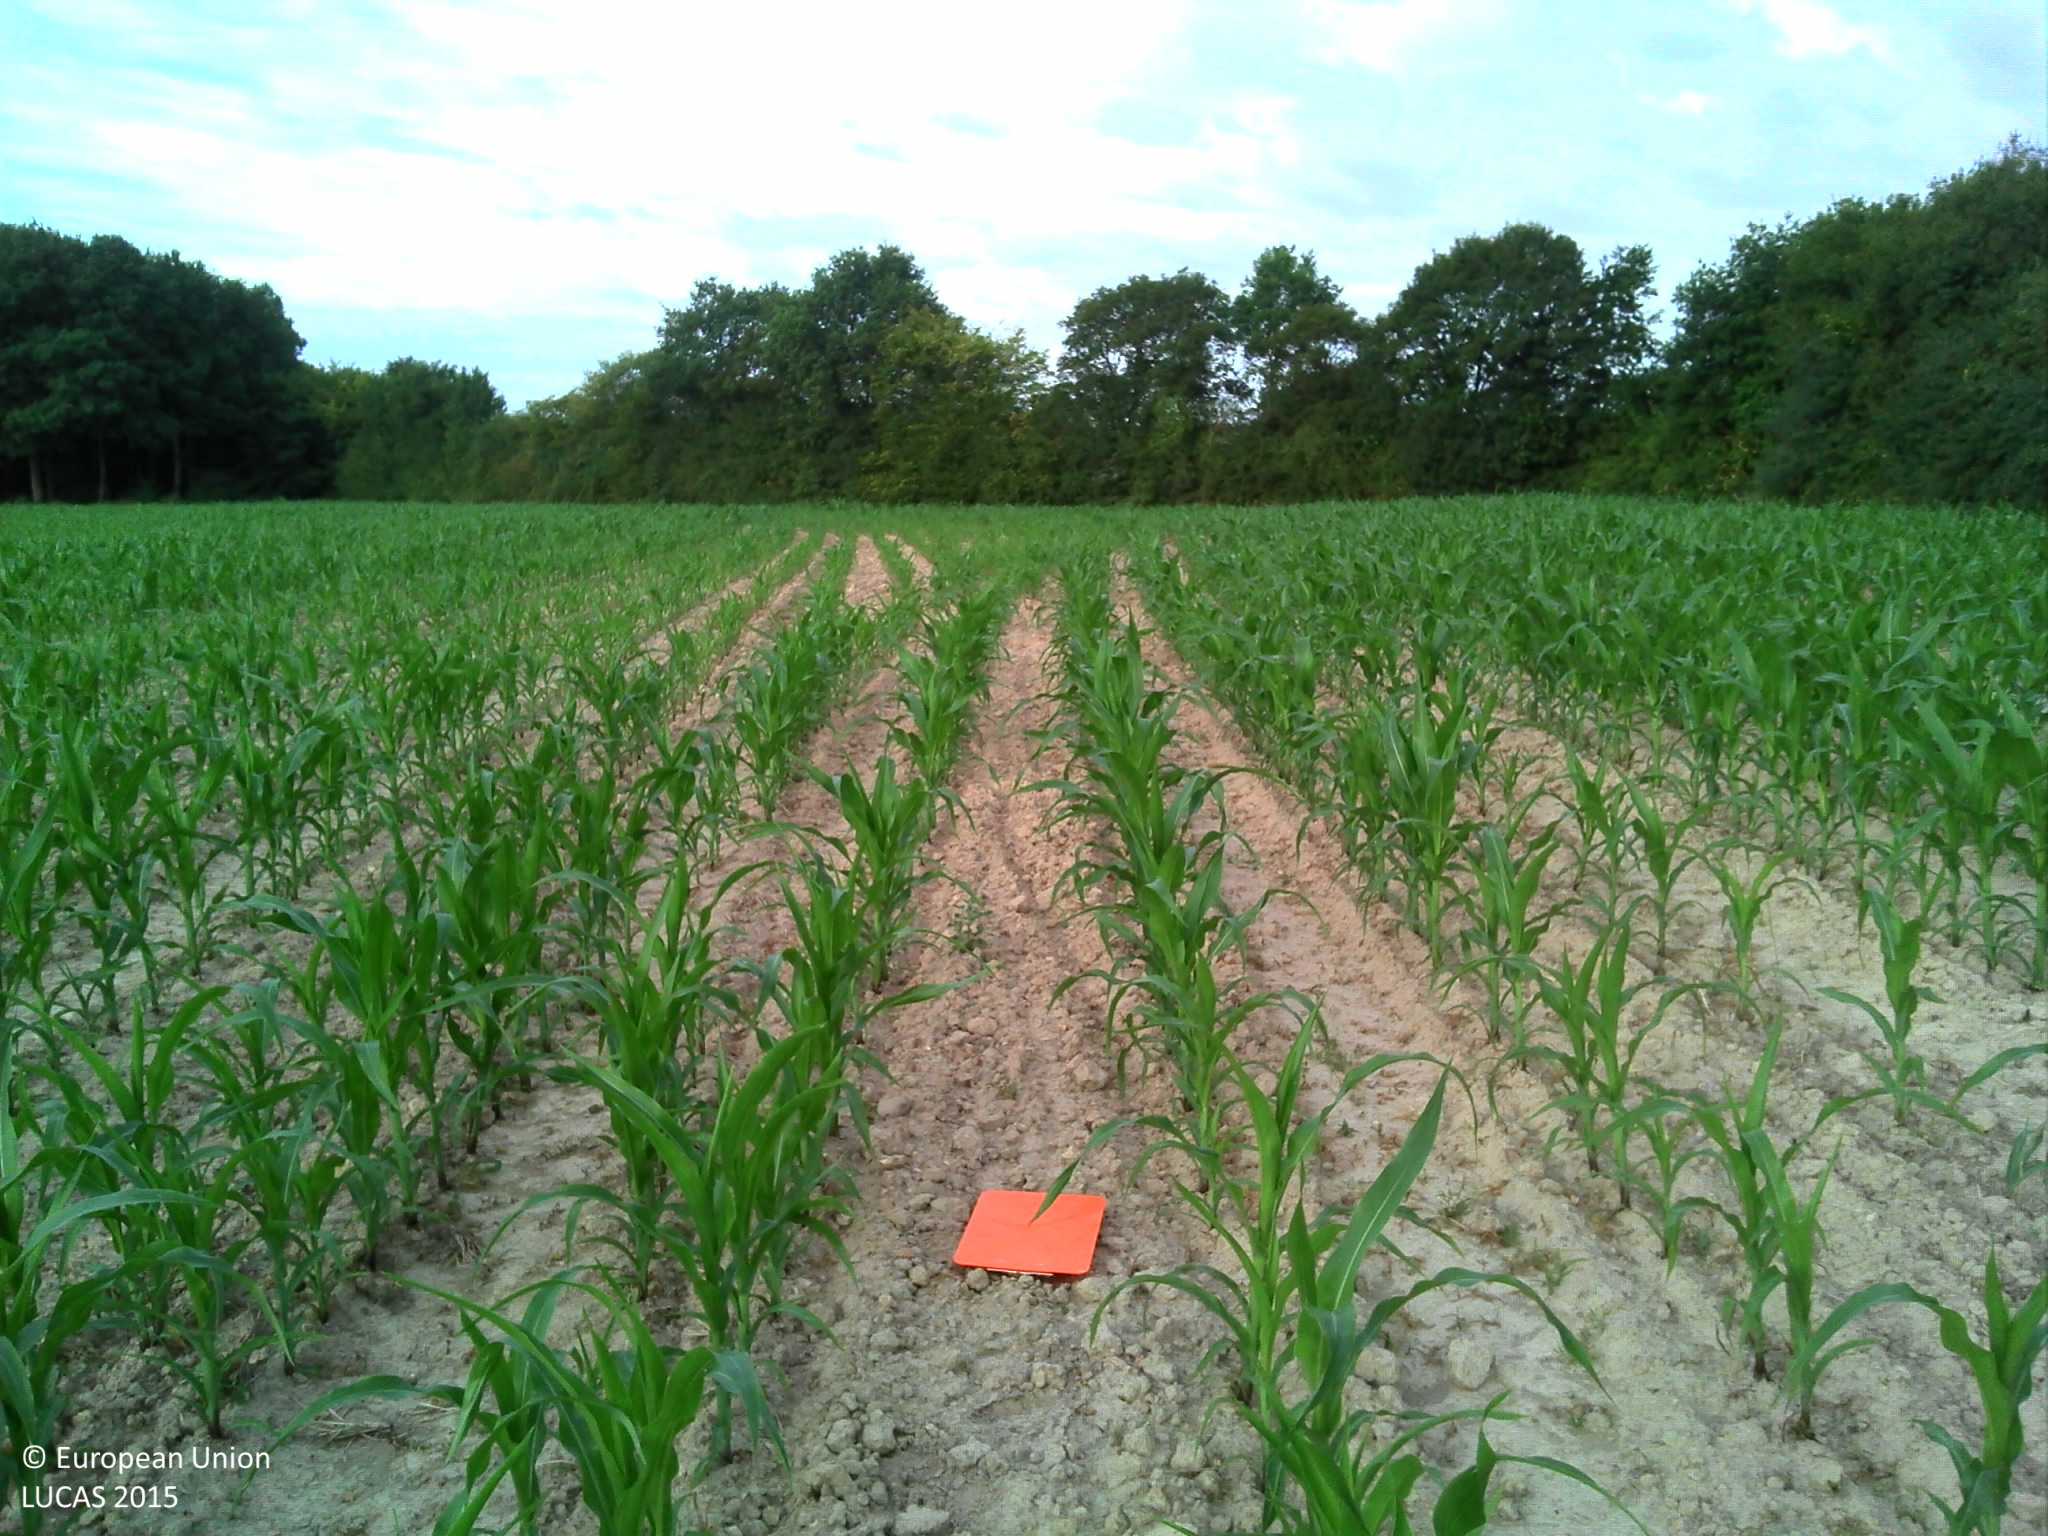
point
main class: Cropland
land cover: Maize
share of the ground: 25 - 50 %
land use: Agriculture (excluding fallow land and kitchen gardens)
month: July
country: FR
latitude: 47.7885
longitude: 0.4329
